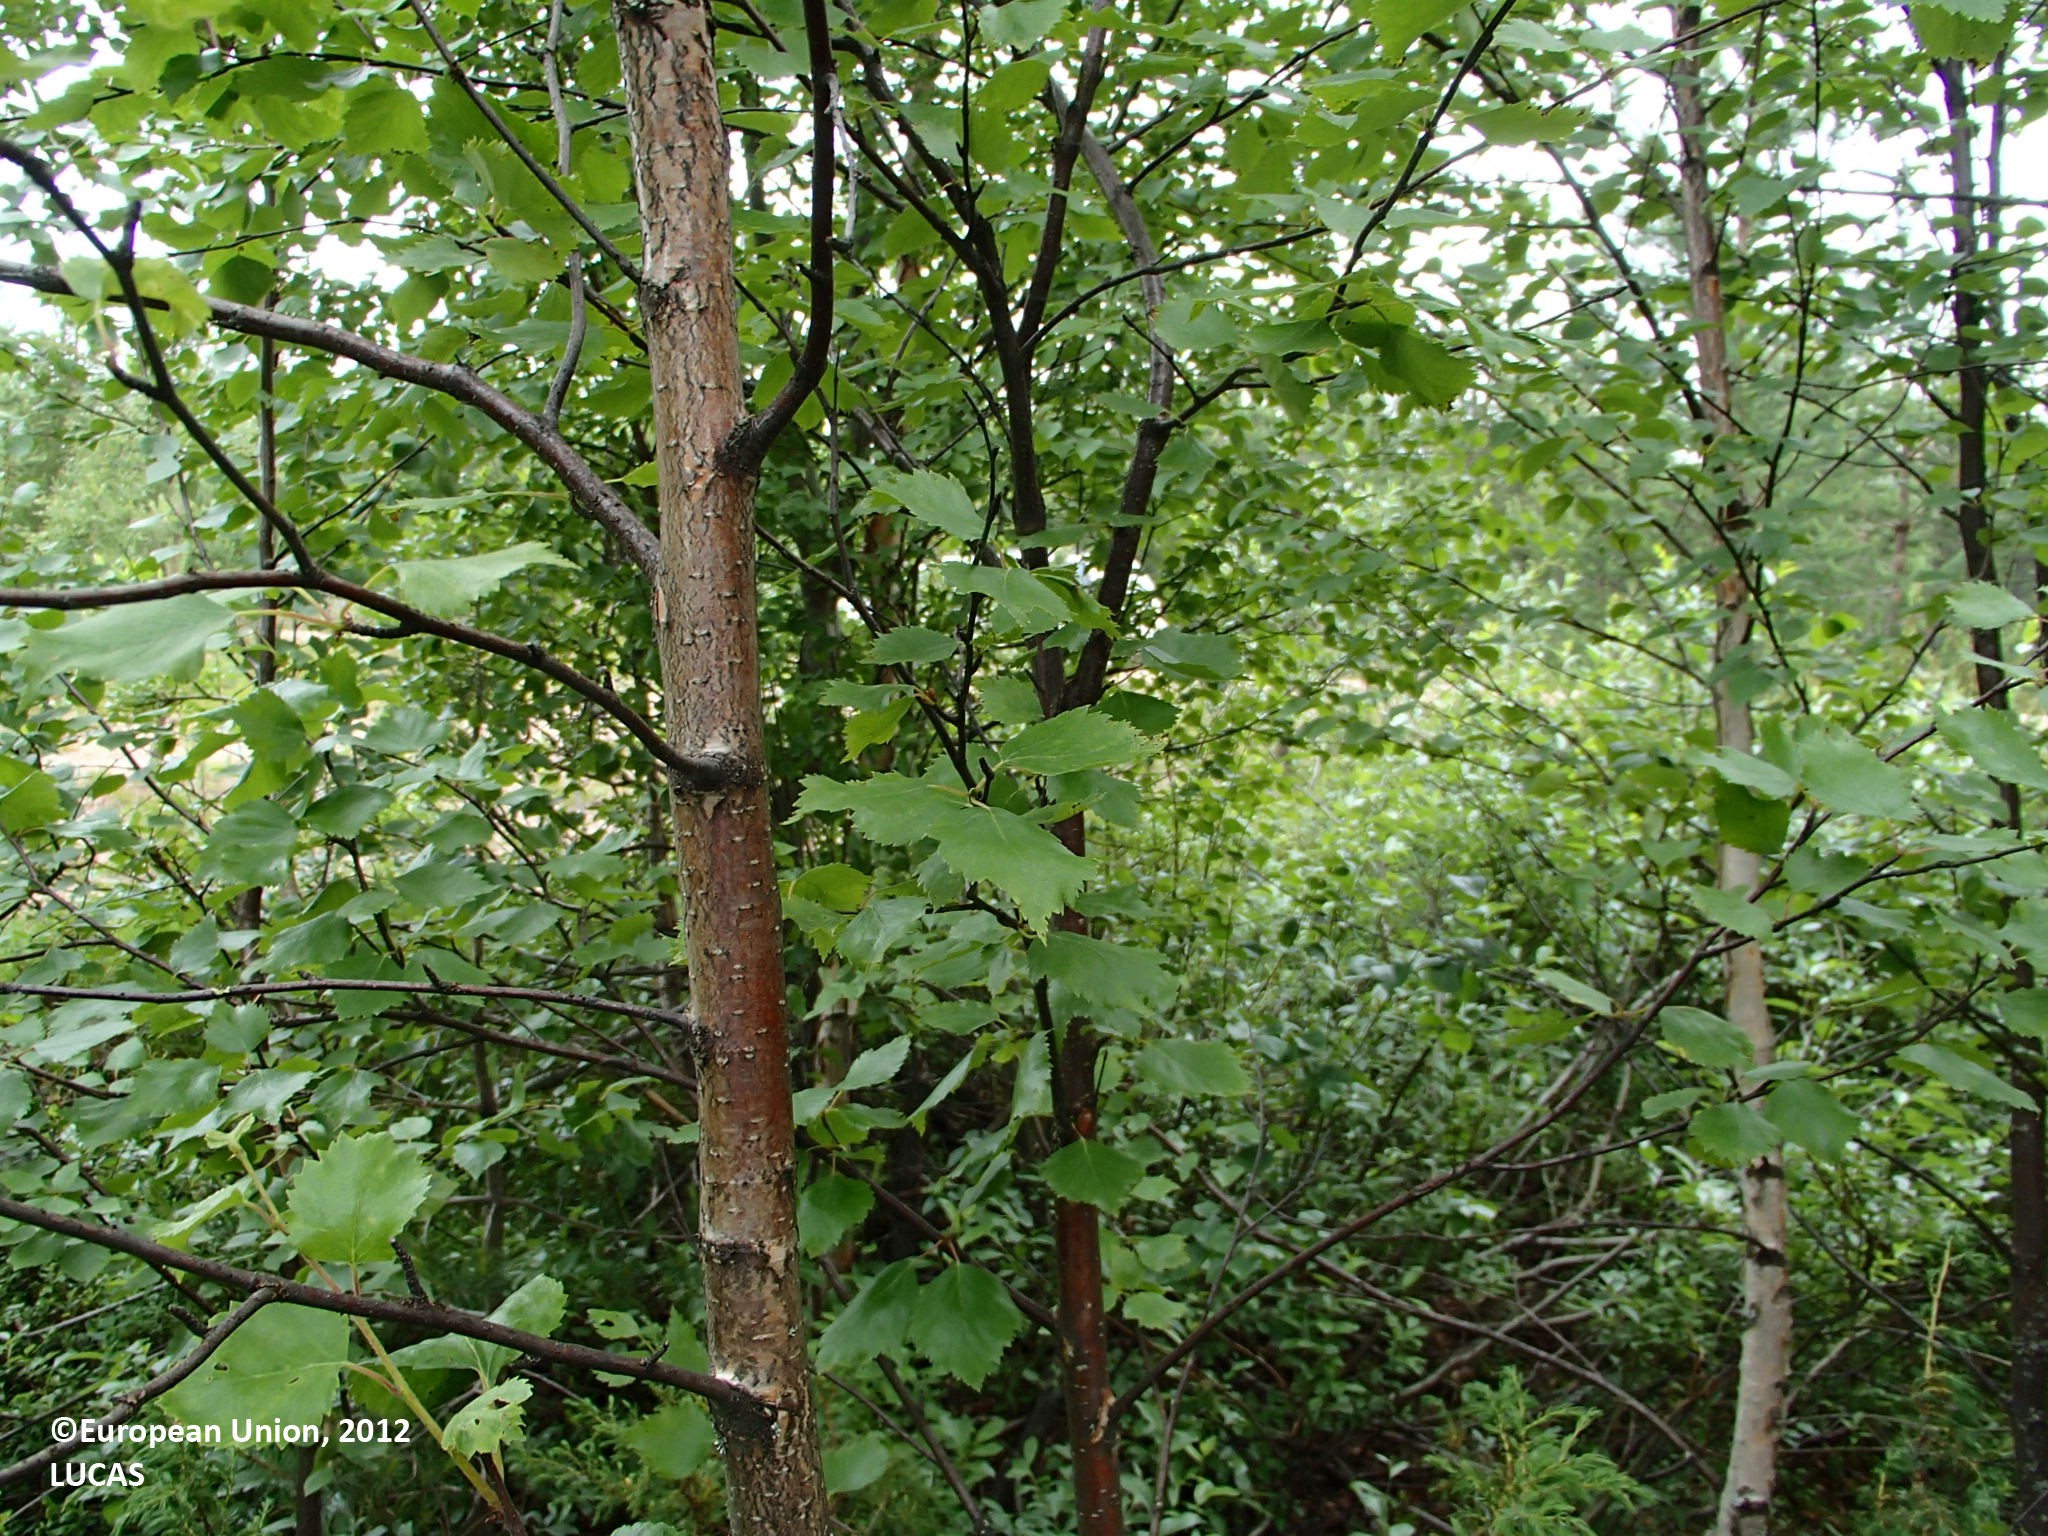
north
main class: Woodland
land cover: Other mixed woodland
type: boreal forest
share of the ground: > 75 %
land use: Forestry
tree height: > 5 m
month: July
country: FI
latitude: 66.9873
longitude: 25.4366
